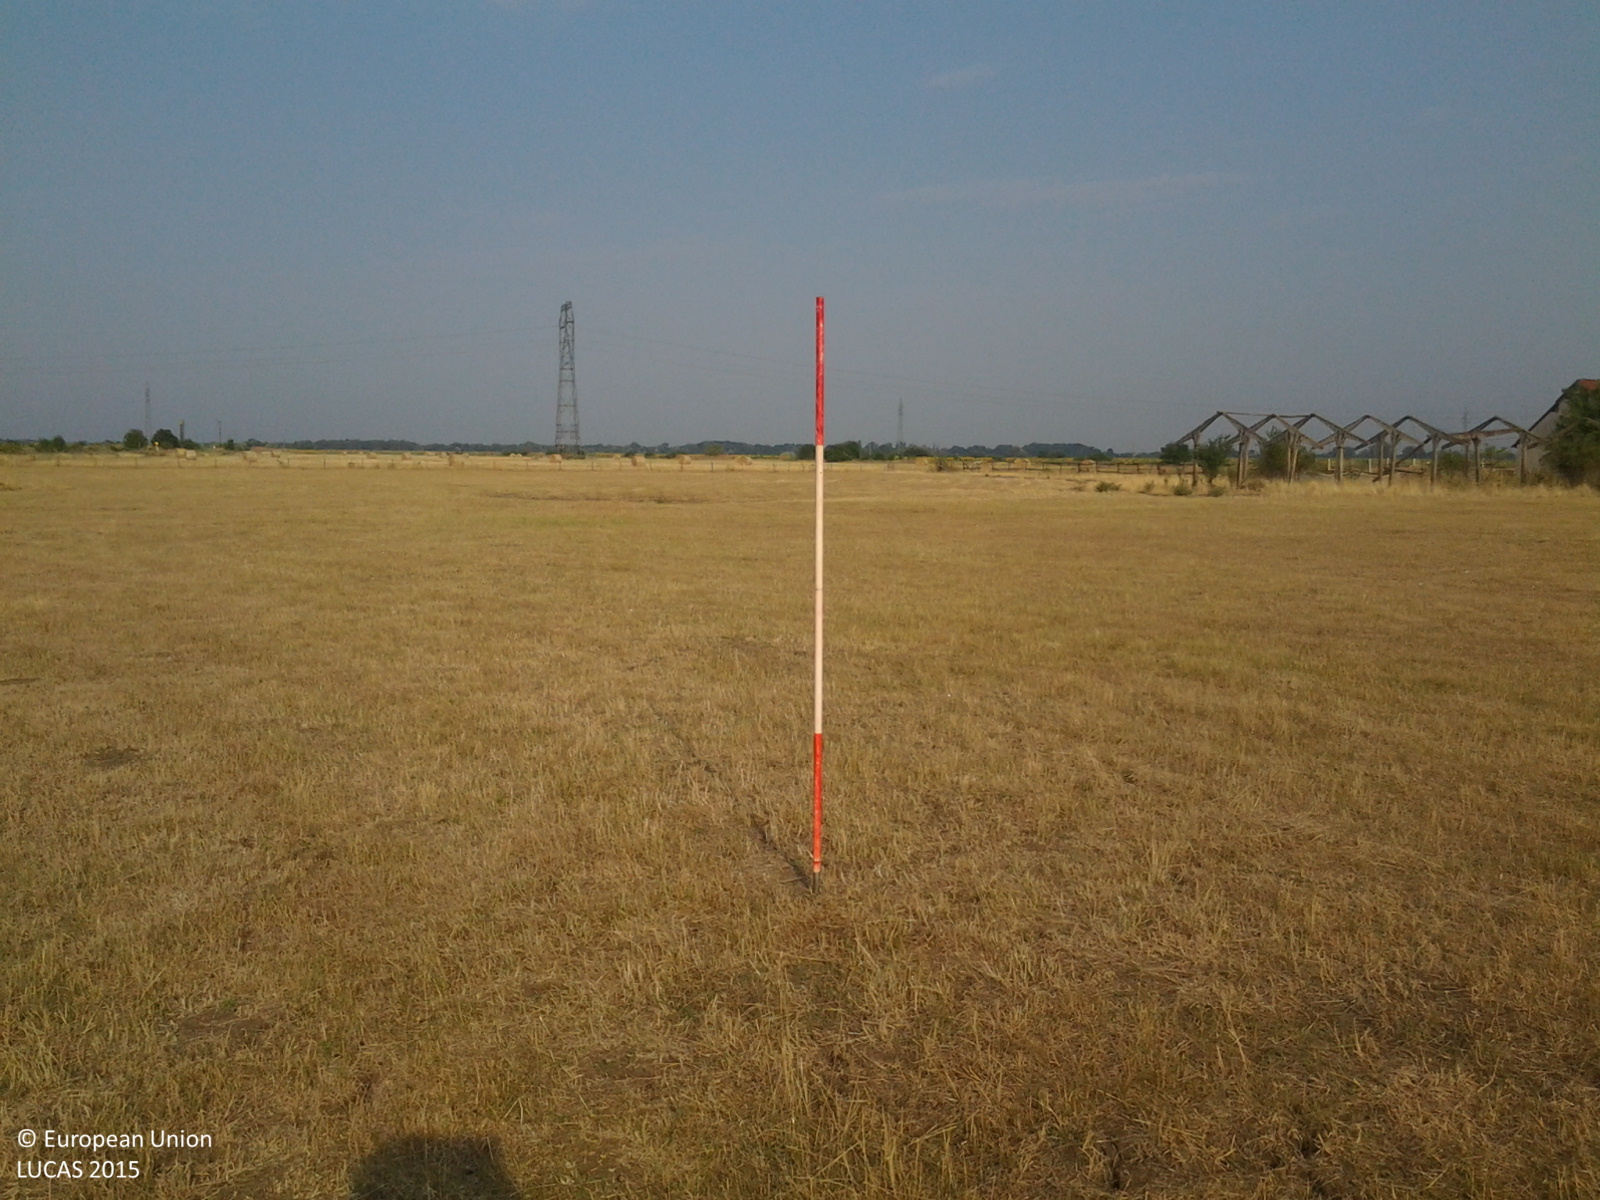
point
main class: Grassland
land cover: Grassland without tree/shrub cover
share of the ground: > 75 %
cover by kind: herbaceous plants 100 %
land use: Agriculture (excluding fallow land and kitchen gardens)
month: July
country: HU
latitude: 46.9785
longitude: 20.6655
